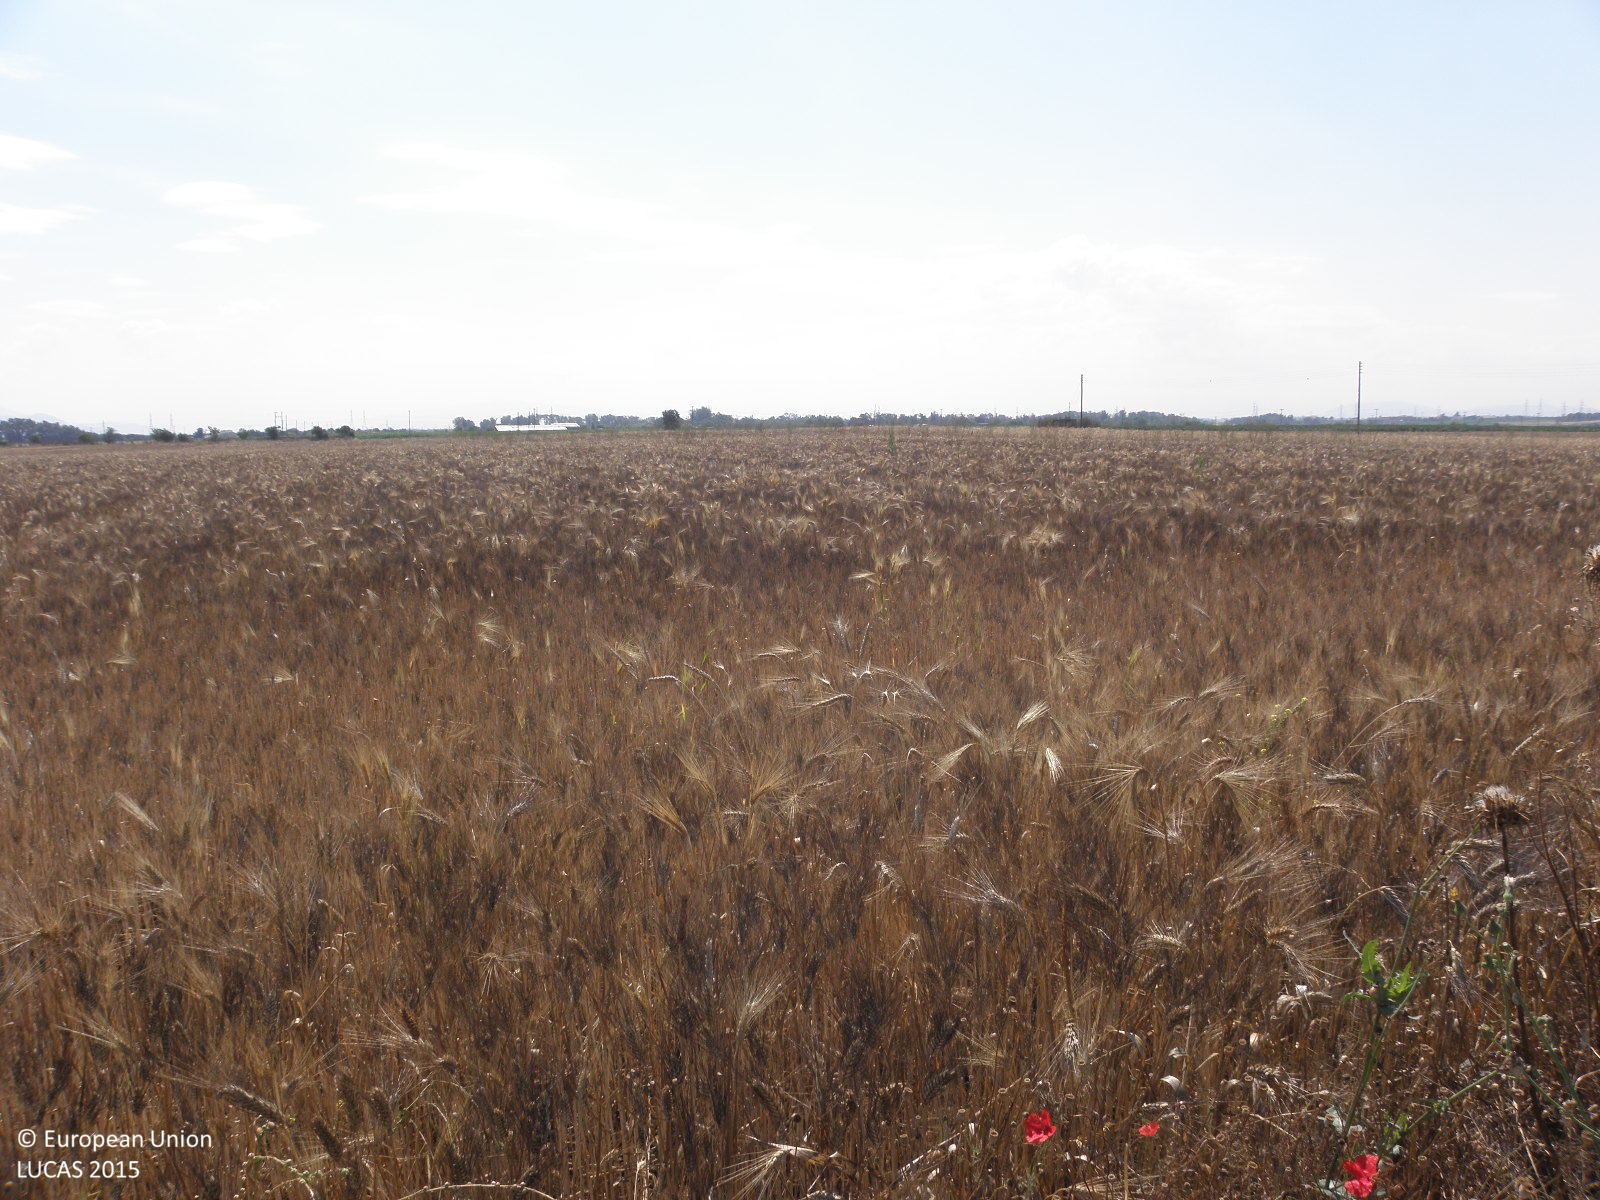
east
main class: Cropland
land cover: Durum wheat
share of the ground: > 75 %
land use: Agriculture (excluding fallow land and kitchen gardens)
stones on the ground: < 10 %
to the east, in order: Durum wheat; Grass margins; Cotton
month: June
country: GR
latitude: 39.6508
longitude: 22.3309
